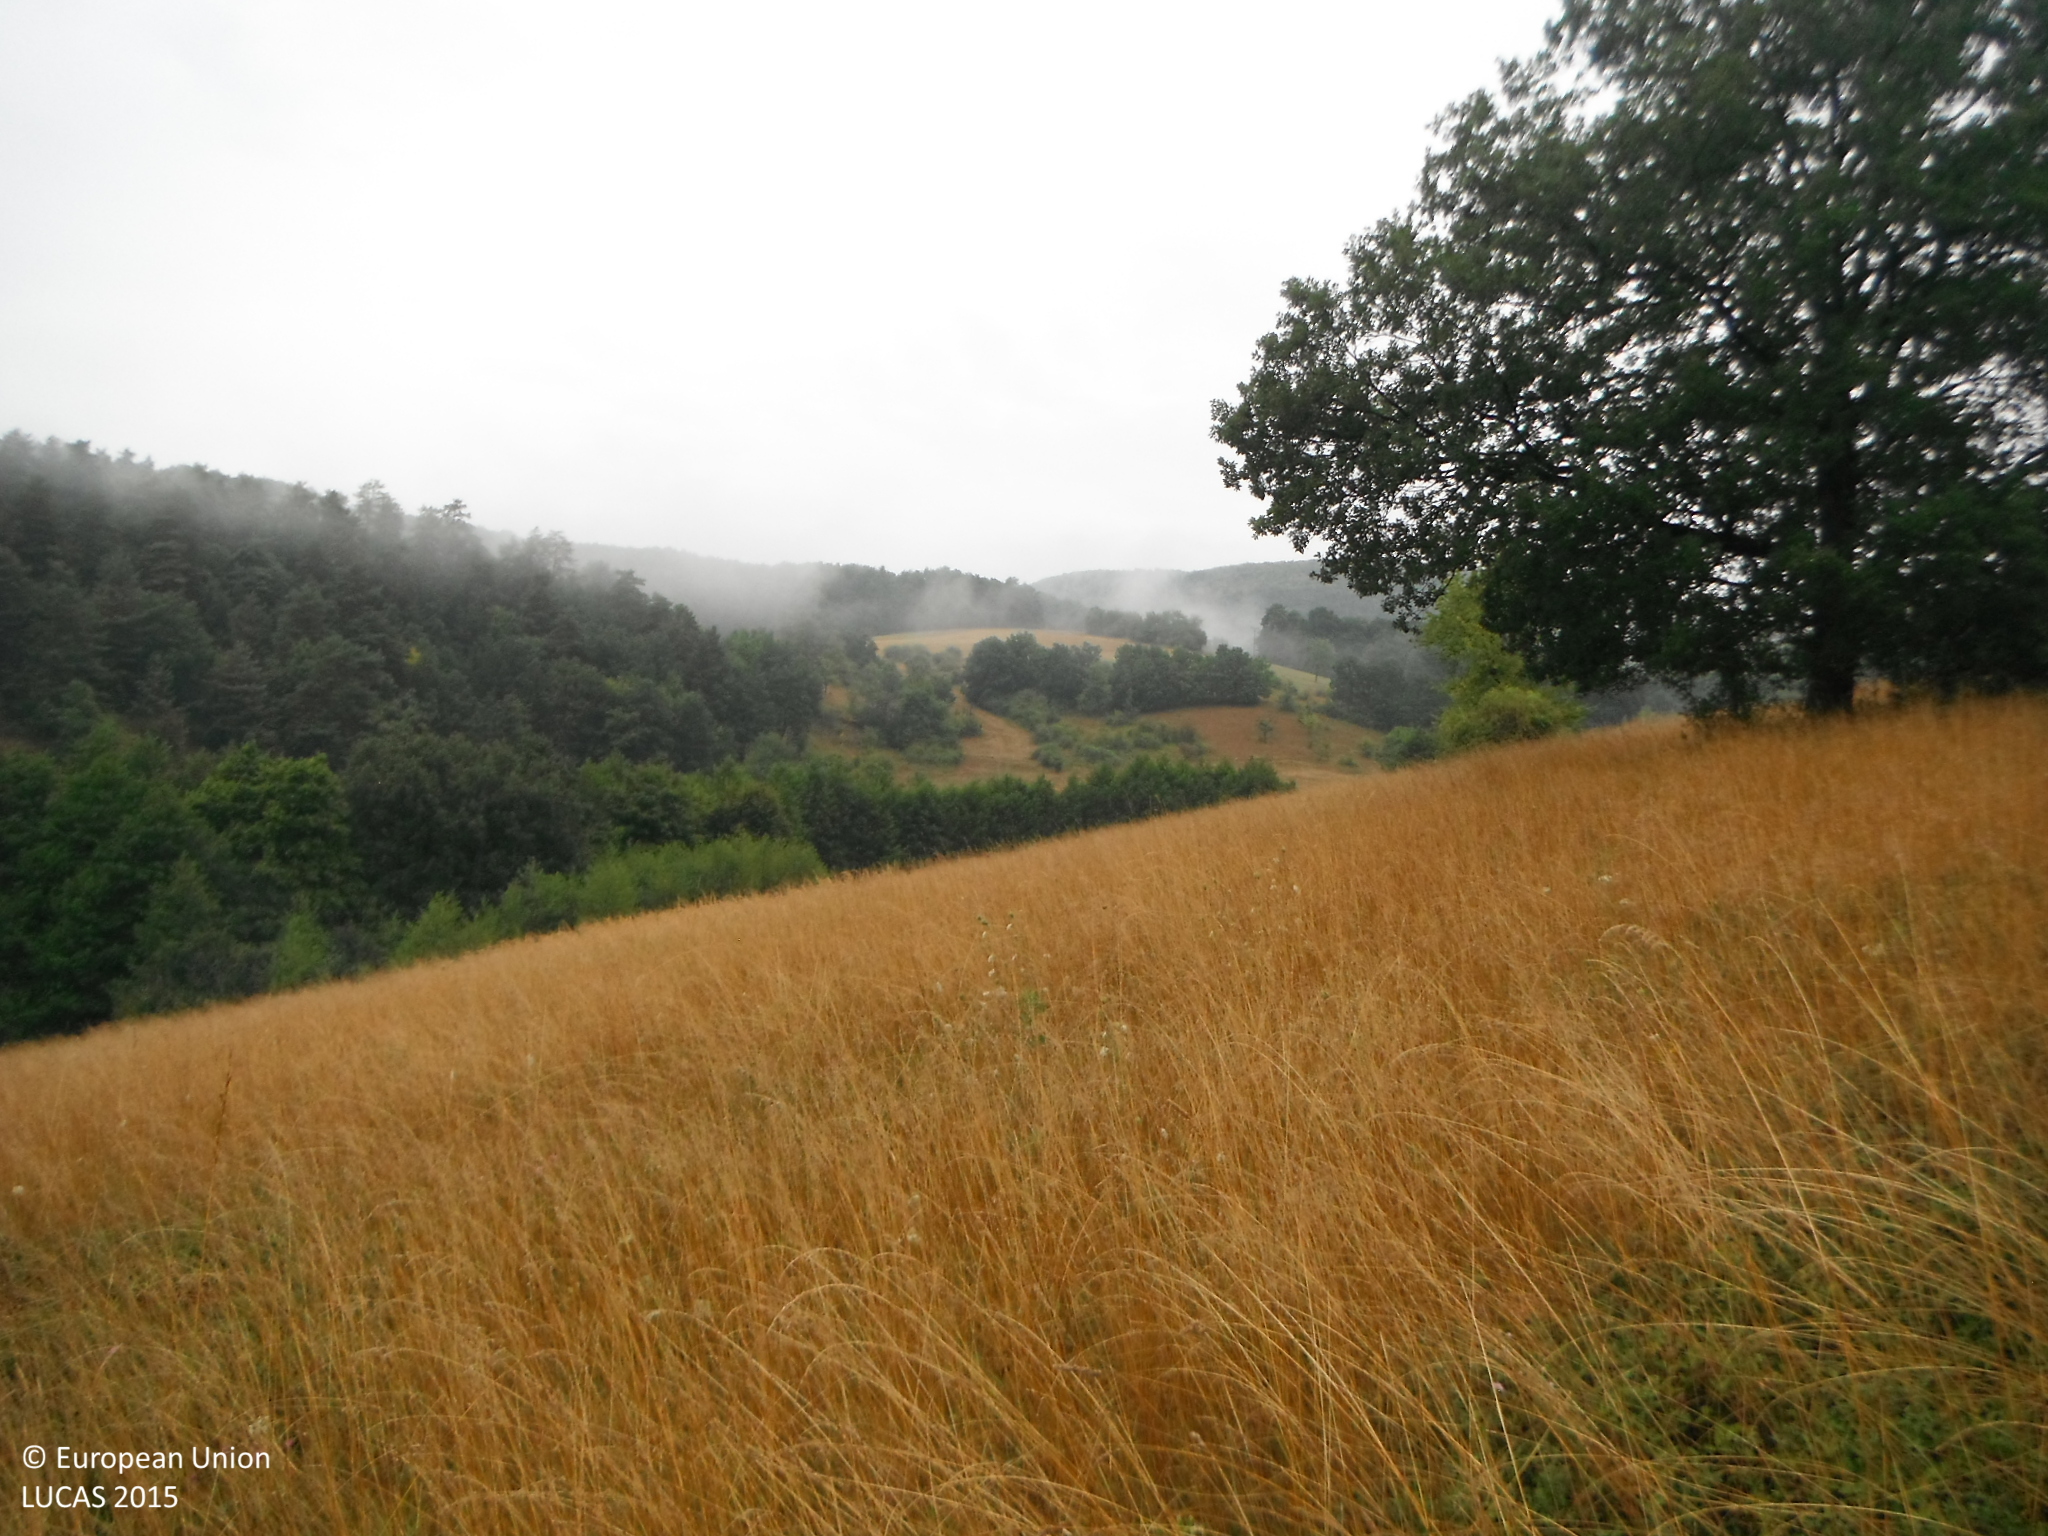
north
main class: Grassland
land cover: Grassland without tree/shrub cover
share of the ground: > 75 %
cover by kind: herbaceous plants 100 %
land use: Agriculture (excluding fallow land and kitchen gardens)
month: August
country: SK
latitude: 48.7774
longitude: 18.5501
